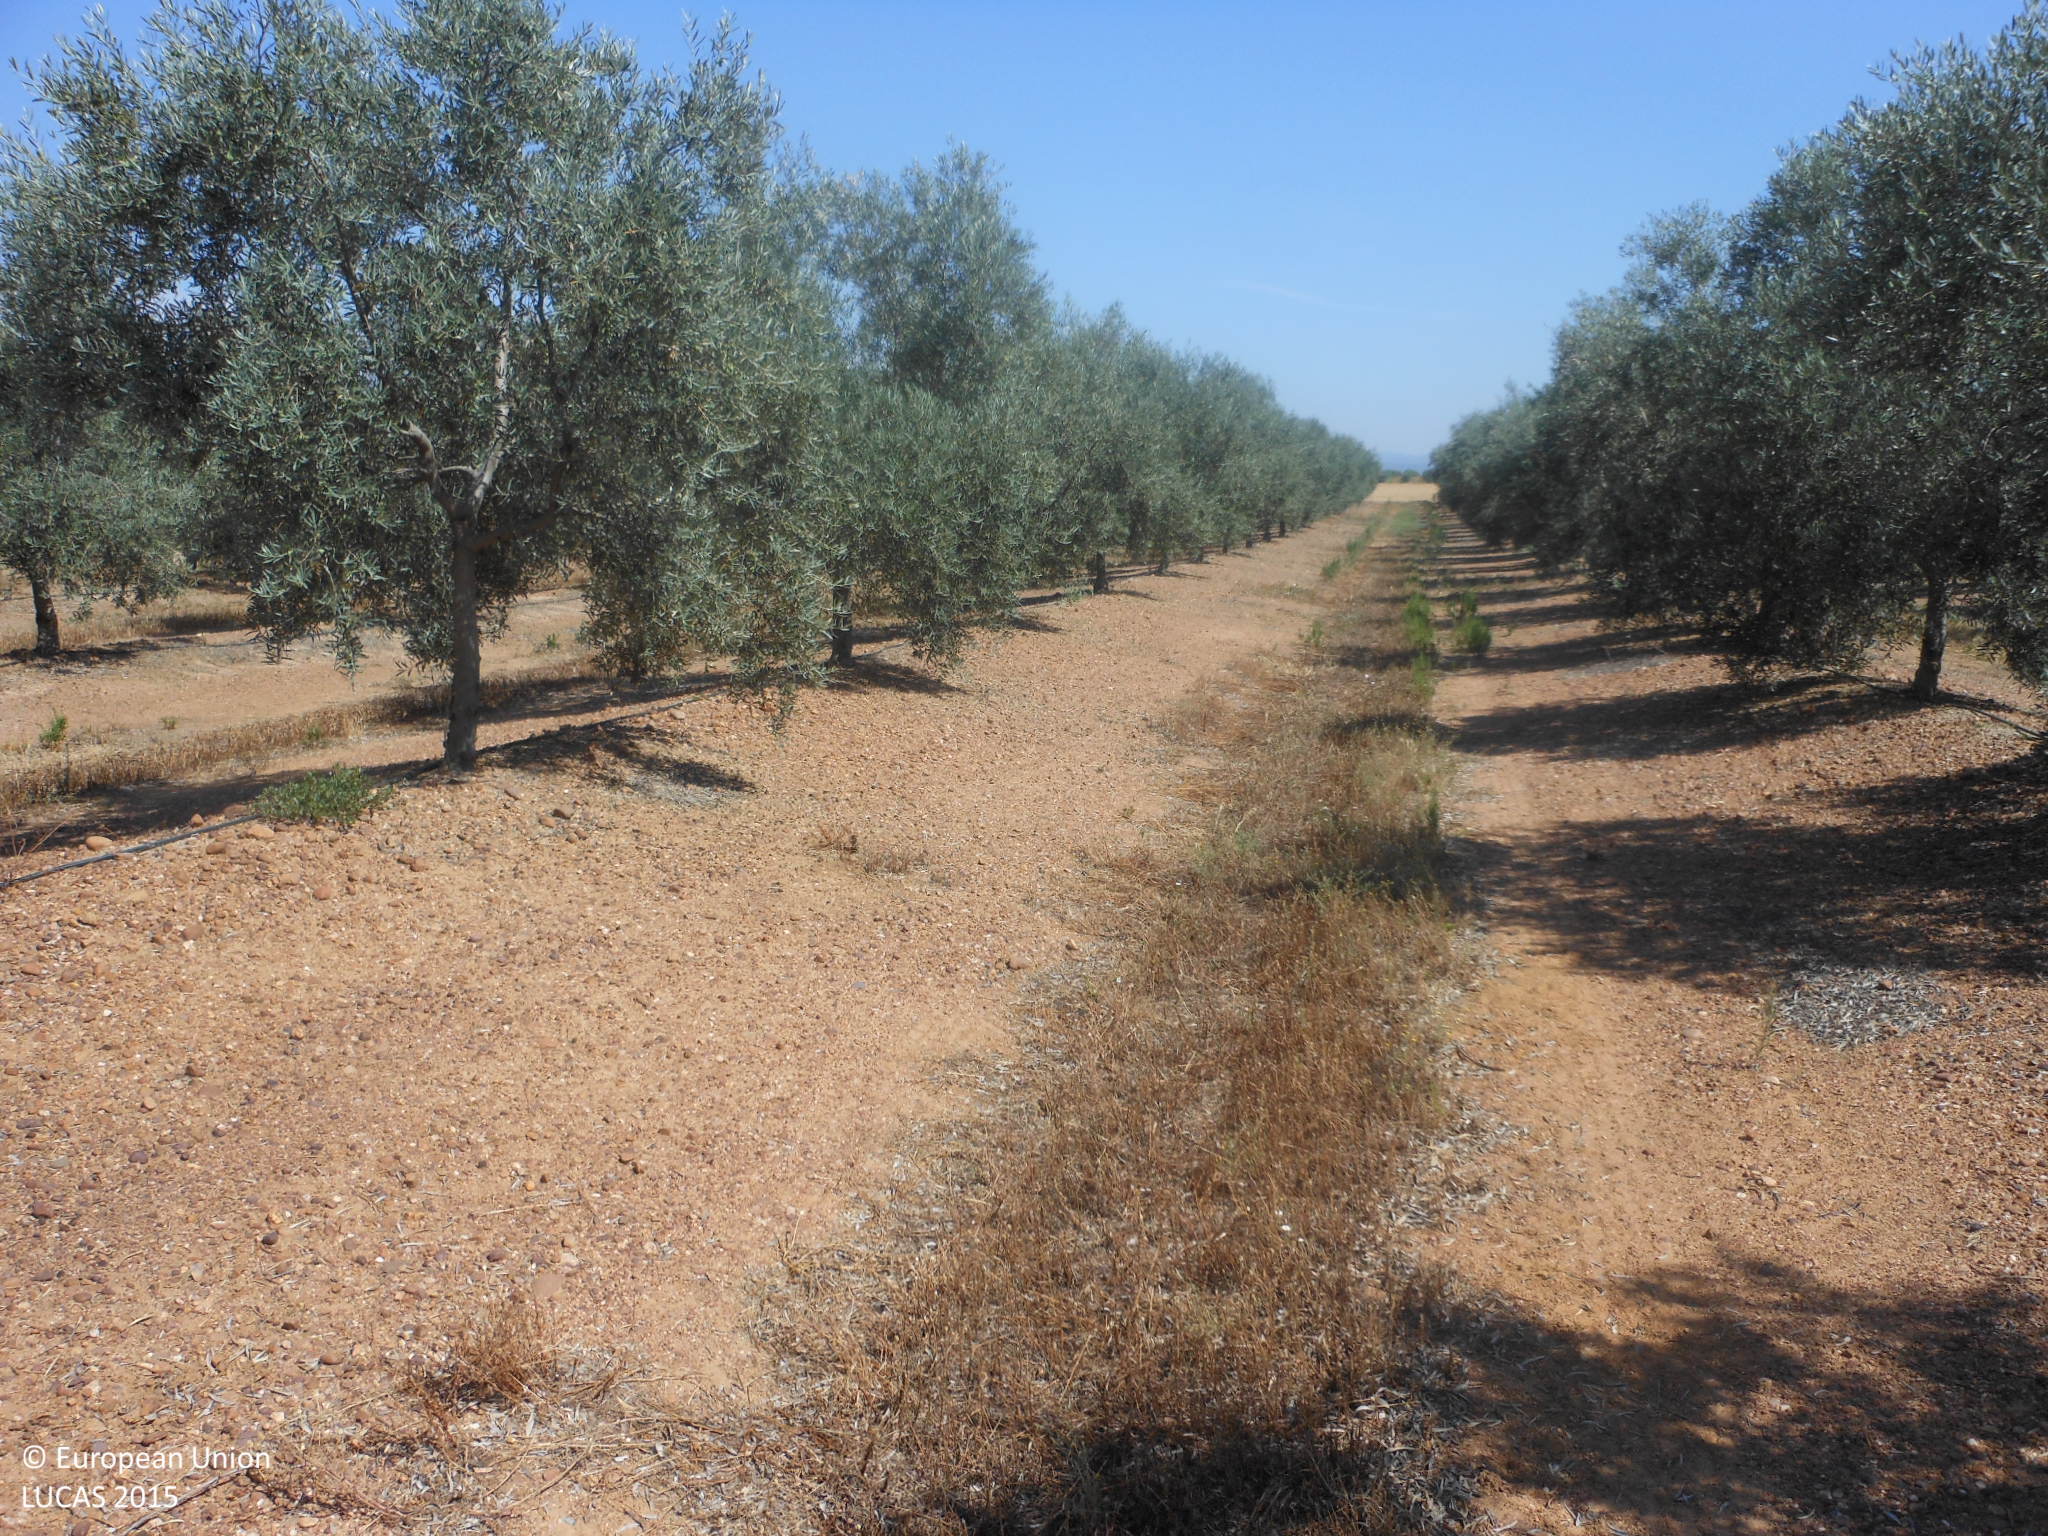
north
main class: Cropland
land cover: Olive groves
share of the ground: 50 - 75 %
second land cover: Spontaneously vegetated surfaces
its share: 10 - 25 %
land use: Agriculture (excluding fallow land and kitchen gardens)
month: June
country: ES
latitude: 37.6709
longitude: -5.1284
